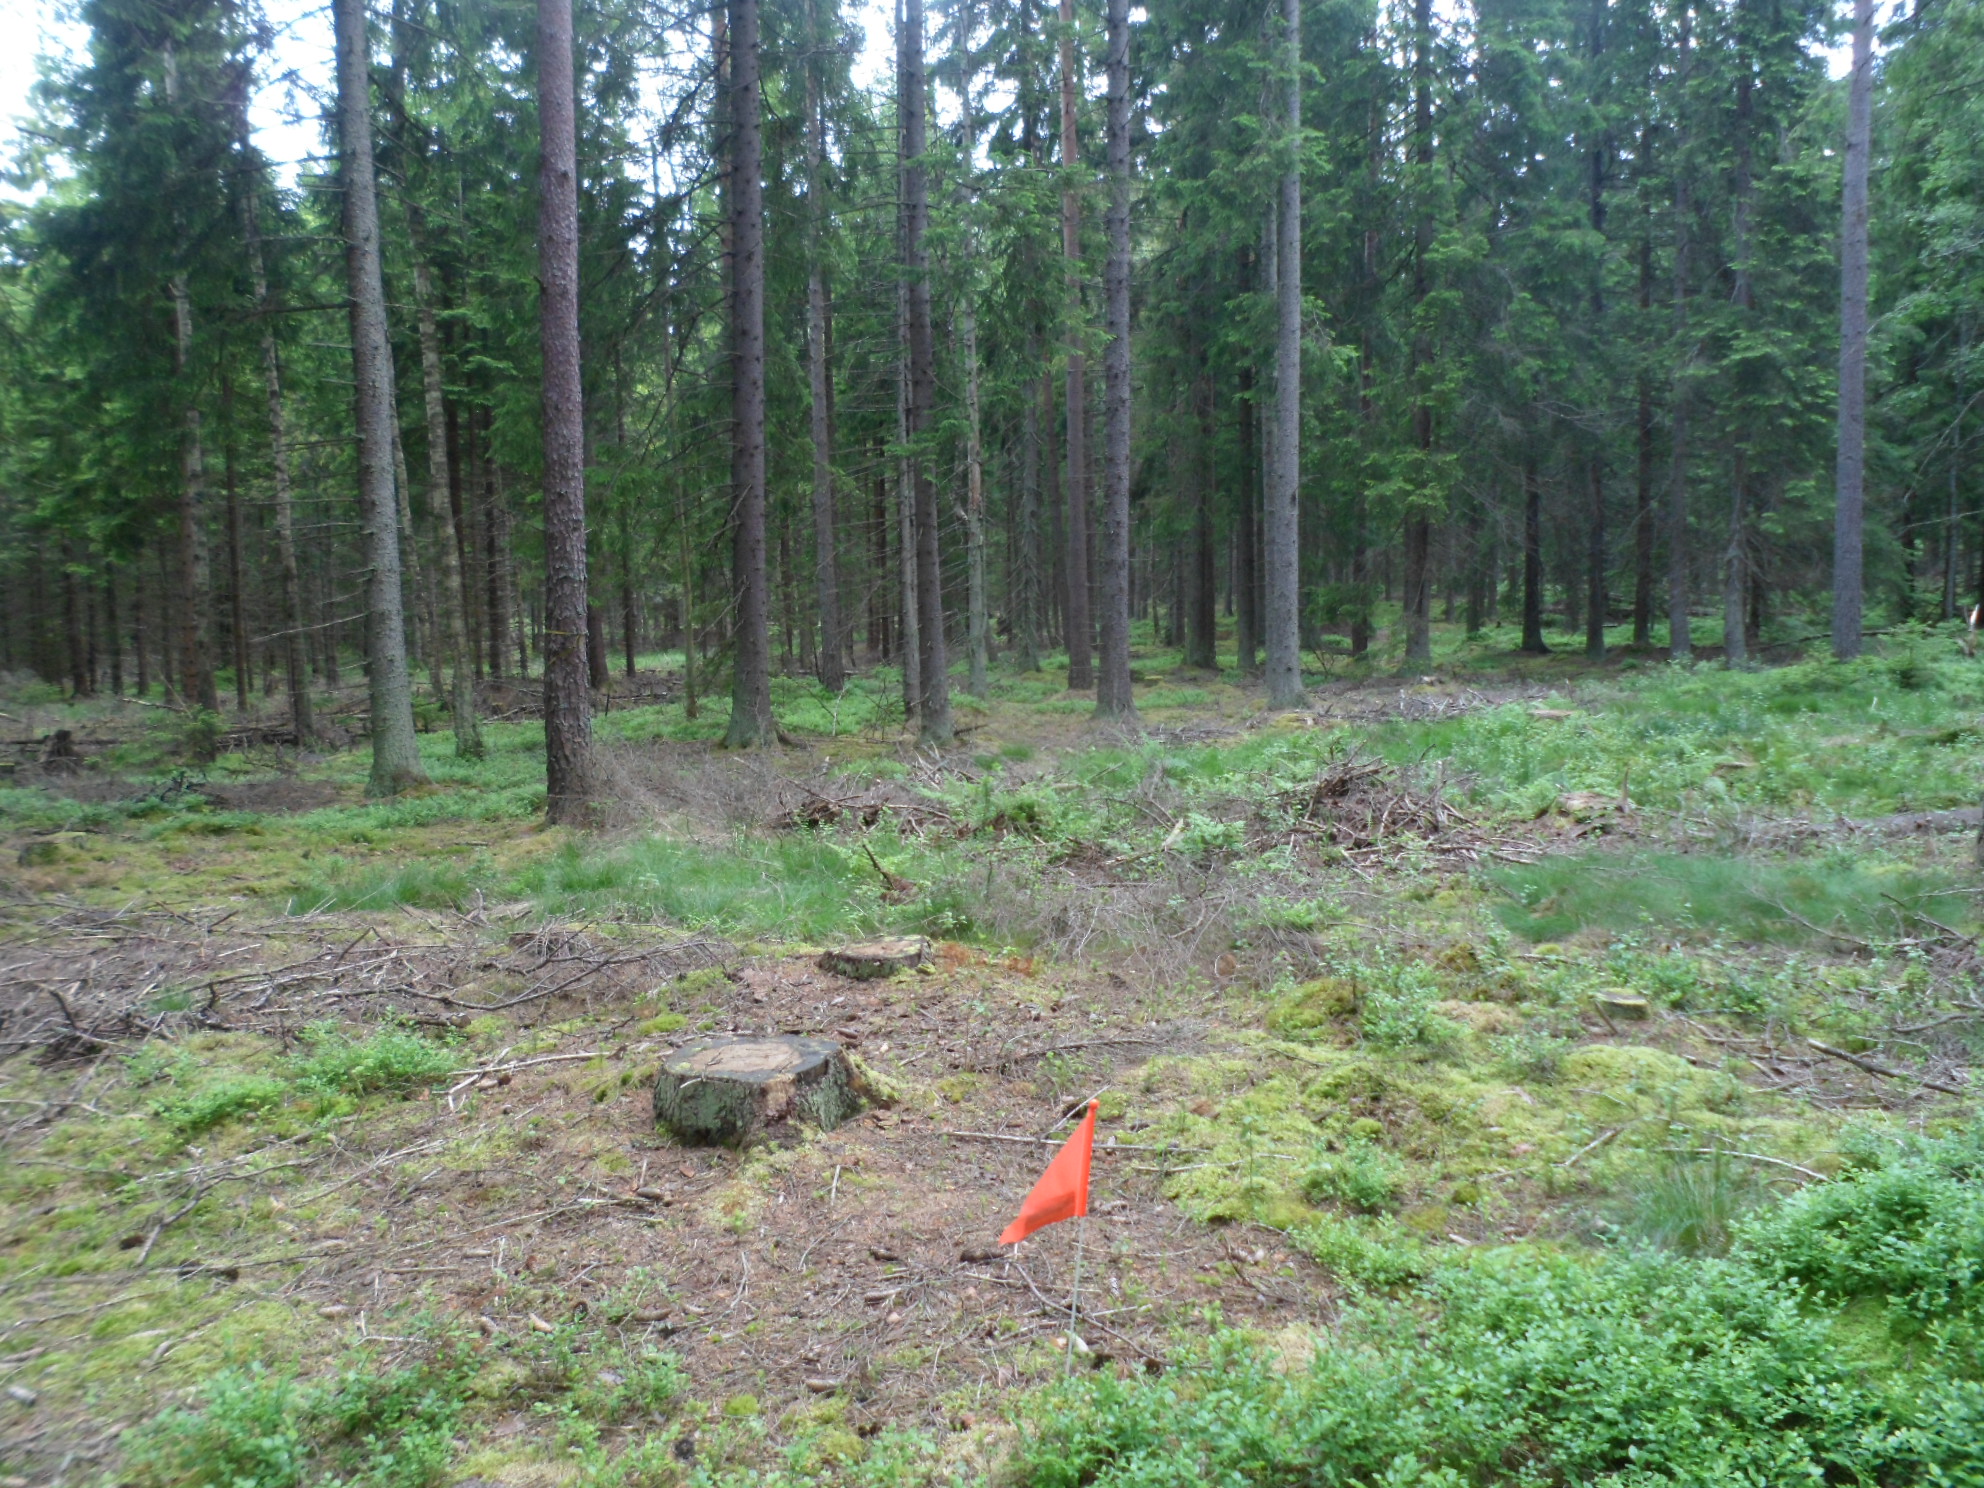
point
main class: Woodland
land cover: Spruce dominated coniferous woodland
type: boreal forest
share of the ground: 50 - 75 %
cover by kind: coniferous forest trees 55 %, lichens and mosses 20 %, shrubs 15 %, herbaceous plants 5 %, unconsolidated bare surface 5 %
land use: Forestry
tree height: > 5 m
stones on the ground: < 10 %
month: June
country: SE
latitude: 57.1083
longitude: 15.2311
